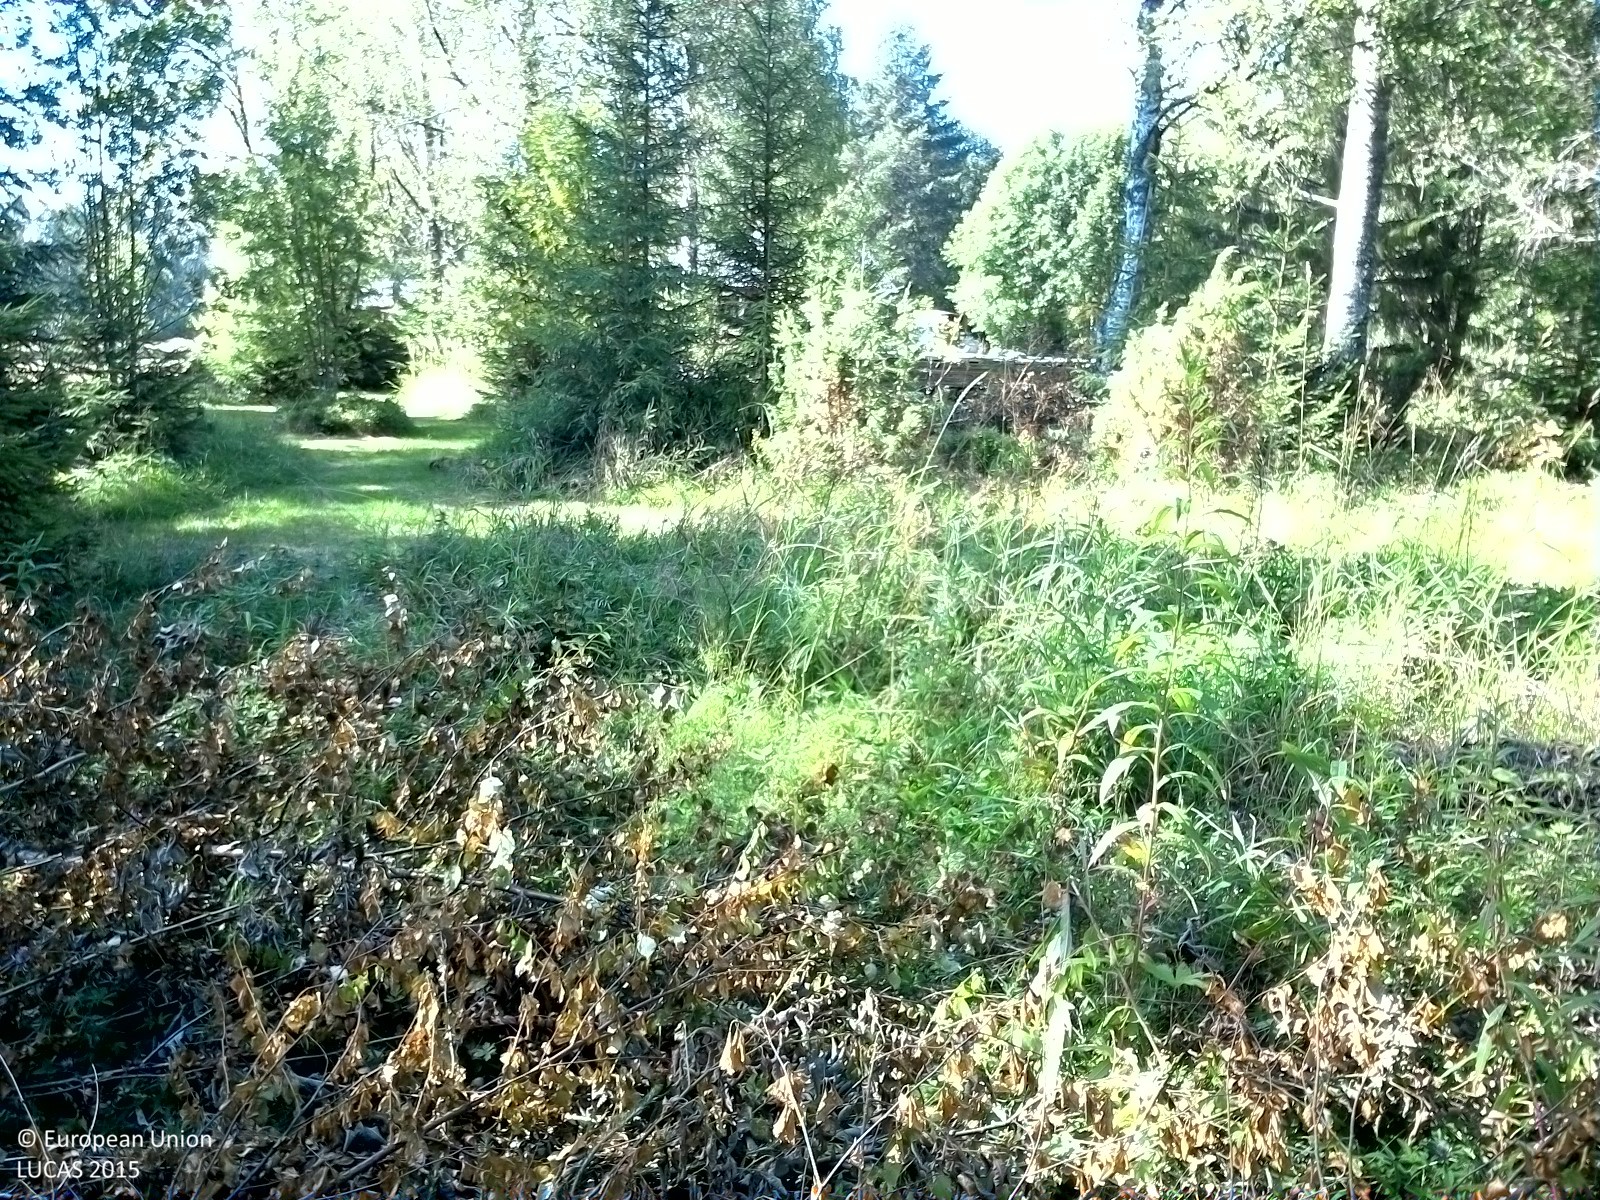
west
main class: Woodland
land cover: Spruce dominated mixed woodland
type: boreal forest
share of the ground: 50 - 75 %
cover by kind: coniferous forest trees 40 %, herbaceous plants 40 %, broadleaved forest trees 15 %
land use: Forestry
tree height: > 5 m
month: August
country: SE
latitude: 62.4039
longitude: 16.8105
